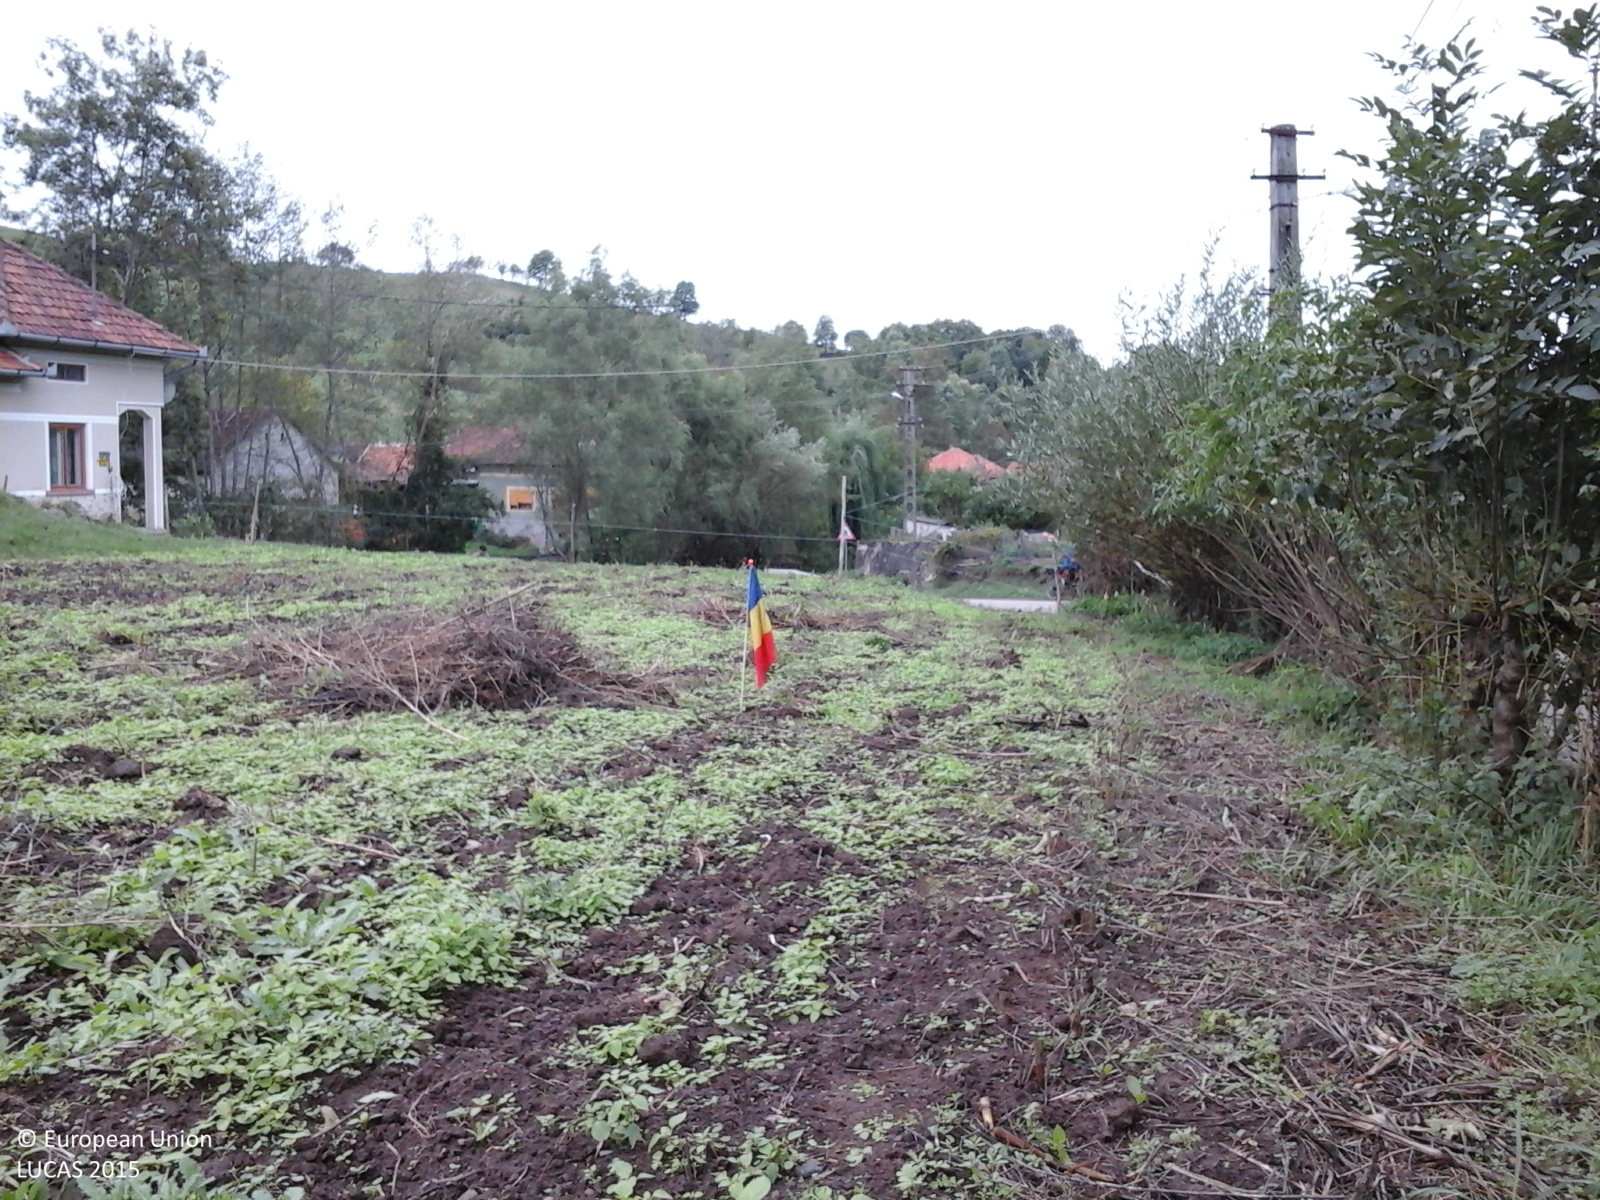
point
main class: Cropland
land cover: Maize
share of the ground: < 10 %
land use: Agriculture (excluding fallow land and kitchen gardens)
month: September
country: RO
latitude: 45.9555
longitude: 22.9966
